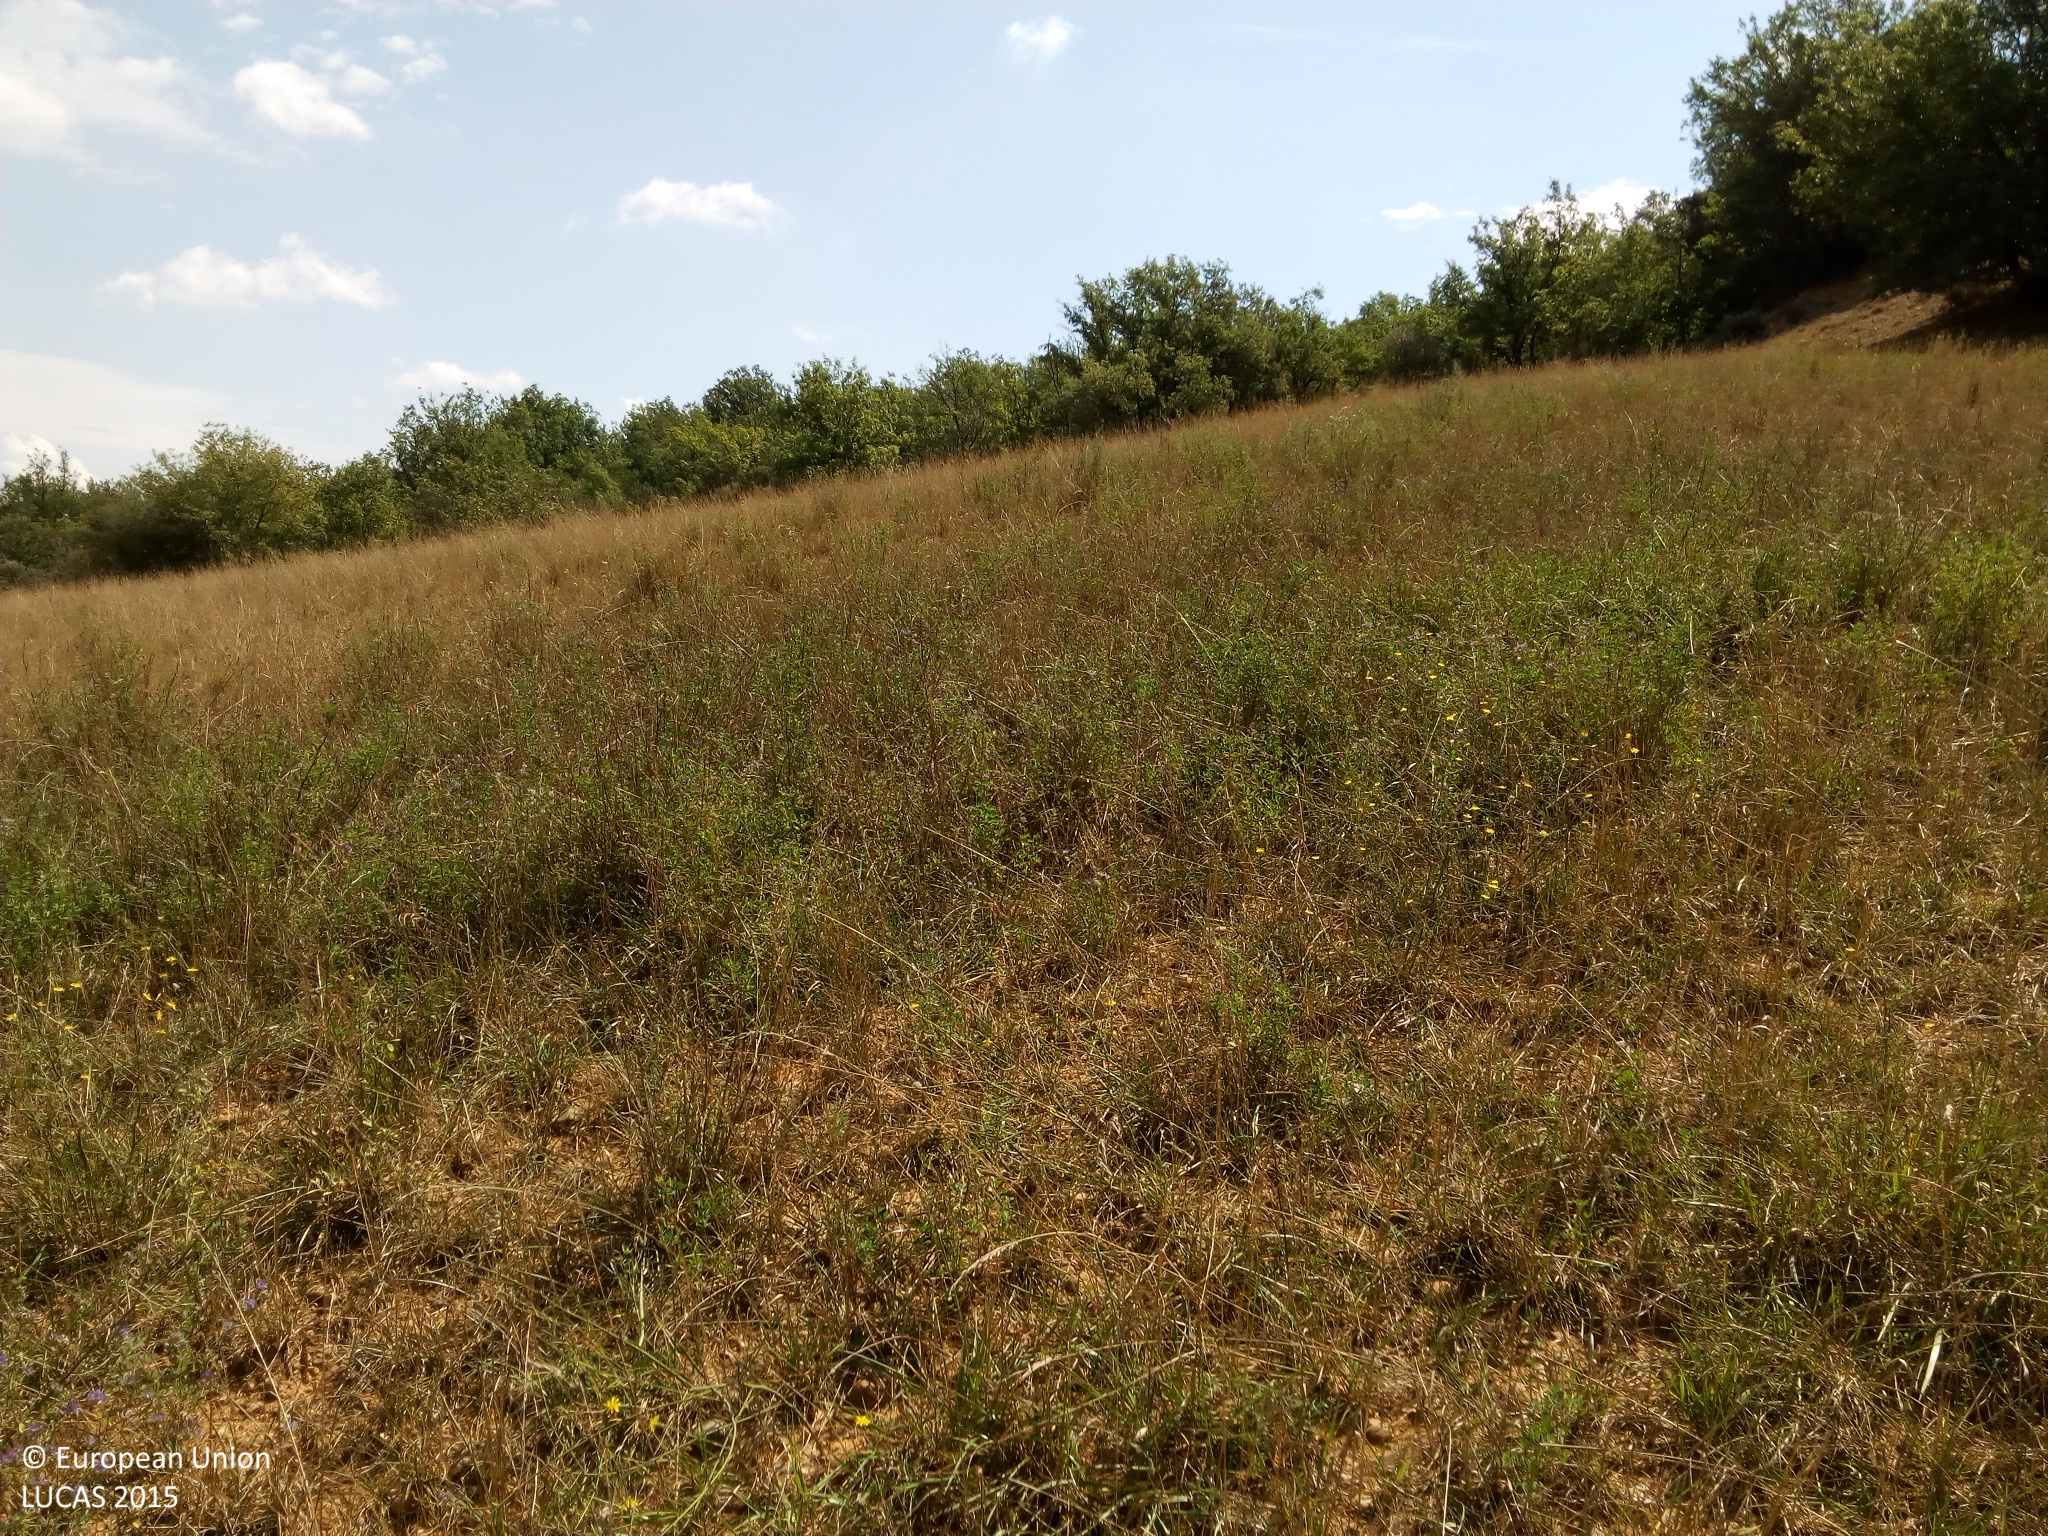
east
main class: Grassland
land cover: Grassland without tree/shrub cover
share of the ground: > 75 %
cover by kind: unconsolidated bare surface 60 %, herbaceous plants 40 %
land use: Agriculture (excluding fallow land and kitchen gardens)
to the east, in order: Grassland without tree/shrub cover; Broadleaved woodland
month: August
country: ES
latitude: 42.0789
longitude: 0.4946
